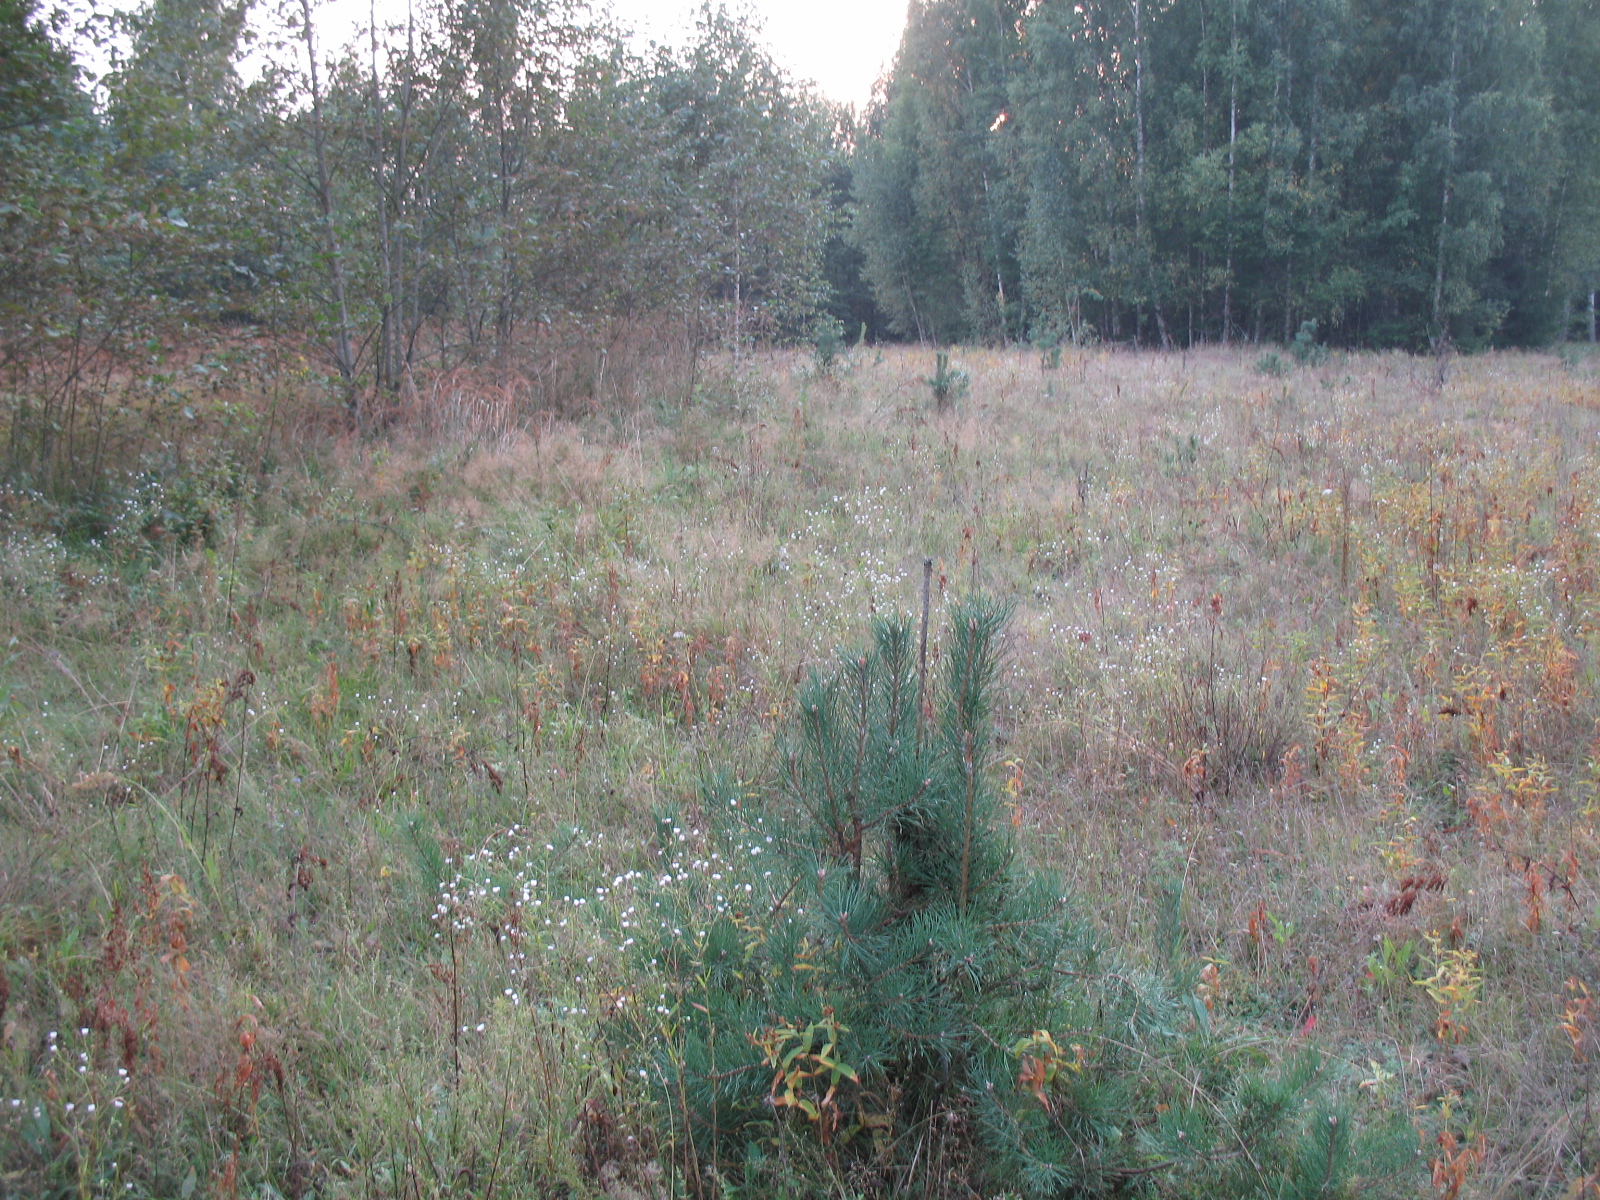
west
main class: Grassland
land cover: Grassland with sparse tree/shrub cover
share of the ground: > 75 %
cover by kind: herbaceous plants 95 %, coniferous forest trees 5 %
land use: Forestry
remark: Nursery
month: September
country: LV
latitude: 56.1520
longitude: 26.2565
